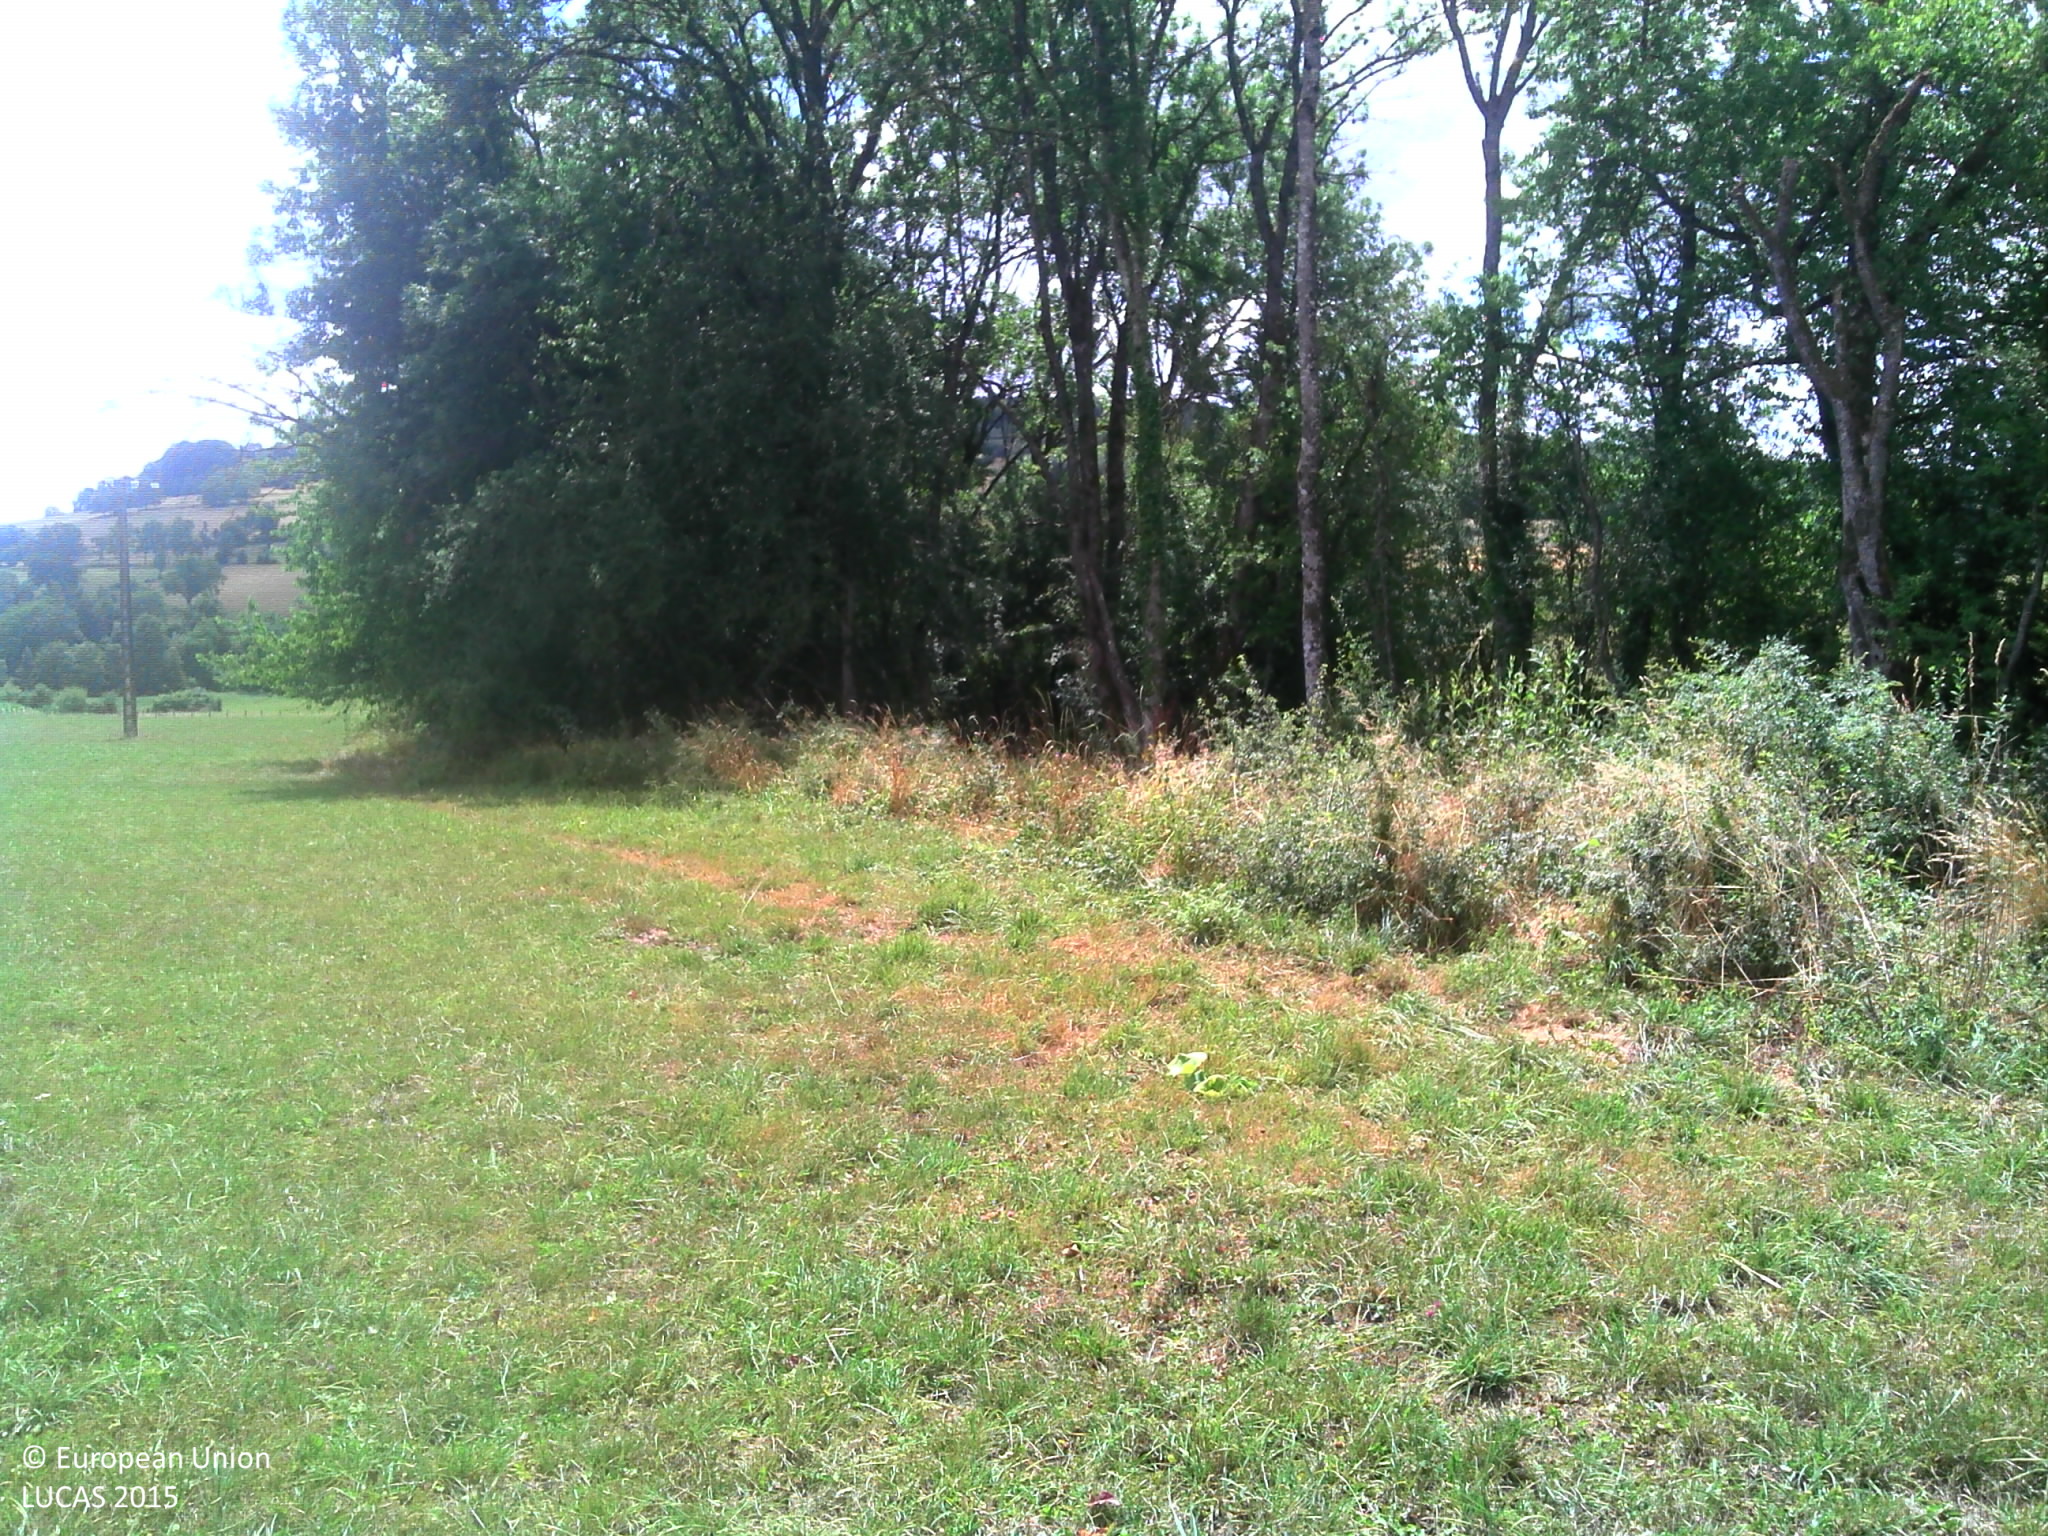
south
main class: Grassland
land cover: Grassland without tree/shrub cover
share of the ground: > 75 %
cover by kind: herbaceous plants 100 %
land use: Agriculture (excluding fallow land and kitchen gardens)
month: July
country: FR
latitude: 47.7601
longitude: 5.2372
